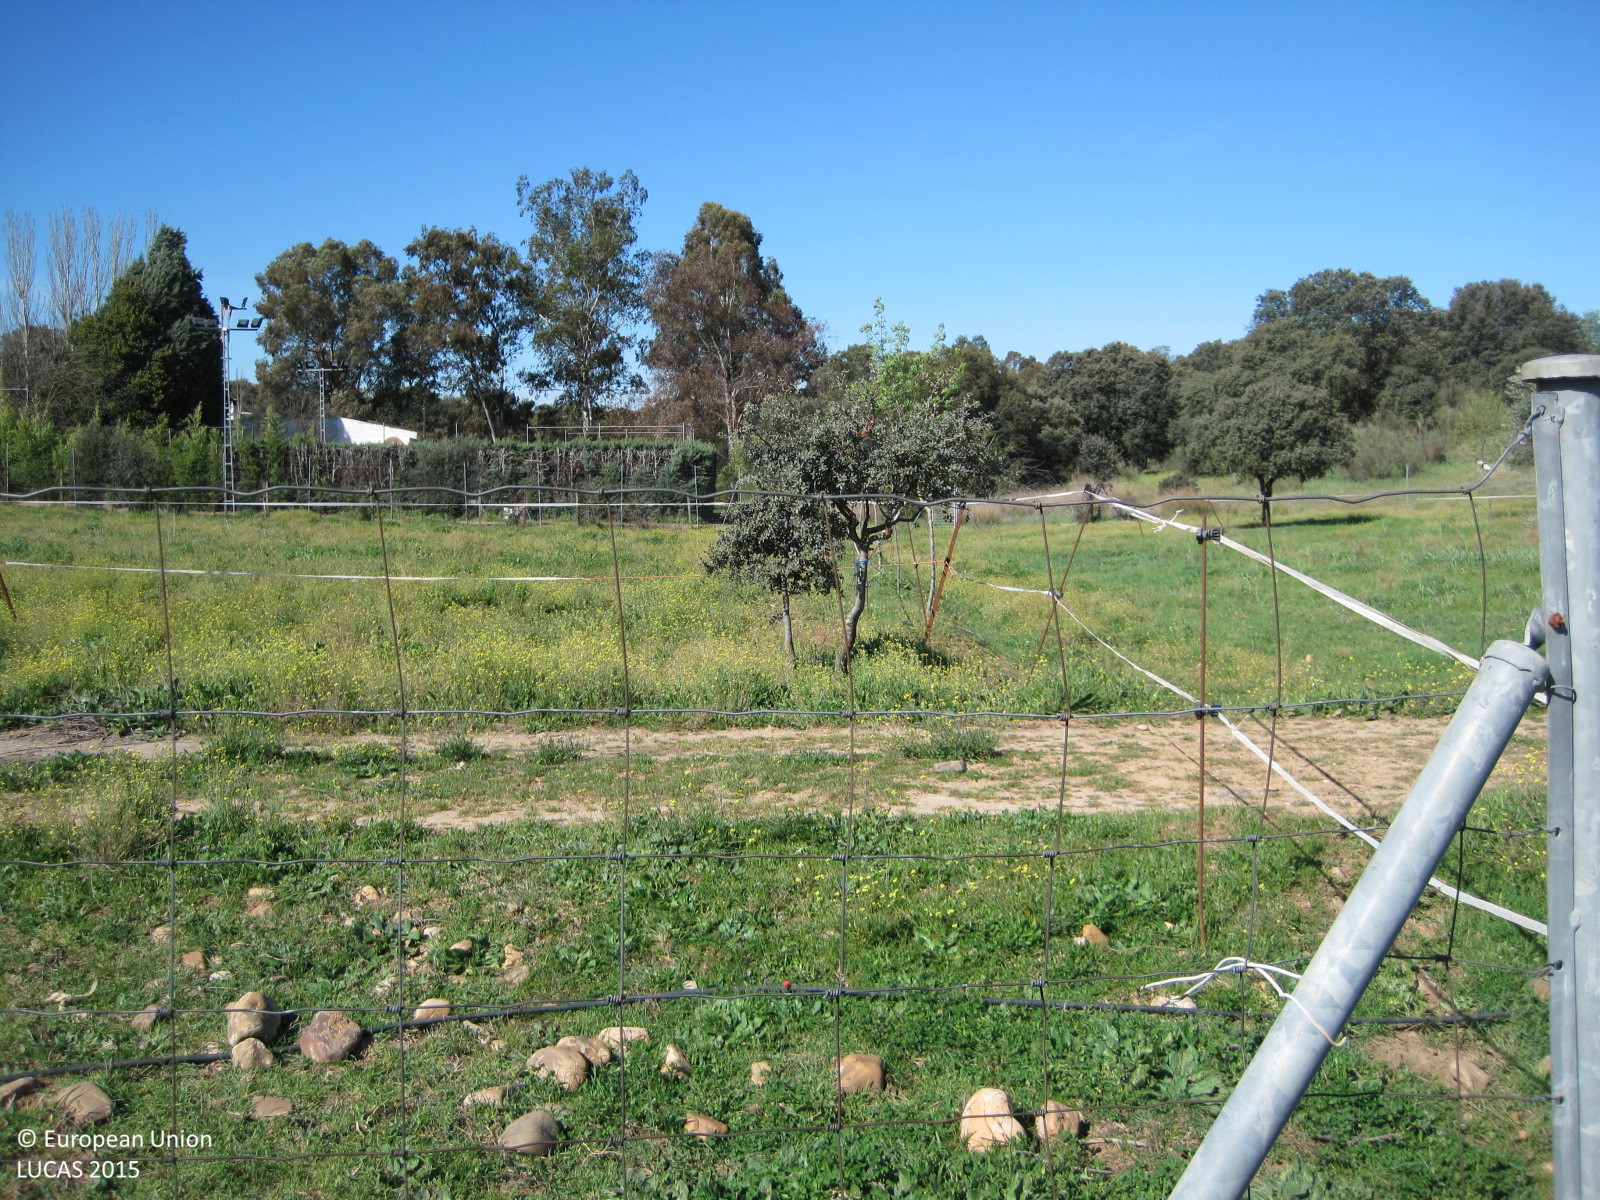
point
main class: Woodland
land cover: Broadleaved woodland
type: thermophilous deciduous forest
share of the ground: > 75 %
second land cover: Grassland without tree/shrub cover
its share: > 75 %
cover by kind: broadleaved forest trees 70 %, herbaceous plants 30 %
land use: Forestry
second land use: Agriculture (excluding fallow land and kitchen gardens)
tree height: > 5 m
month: April
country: ES
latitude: 39.9943
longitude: -4.7220
